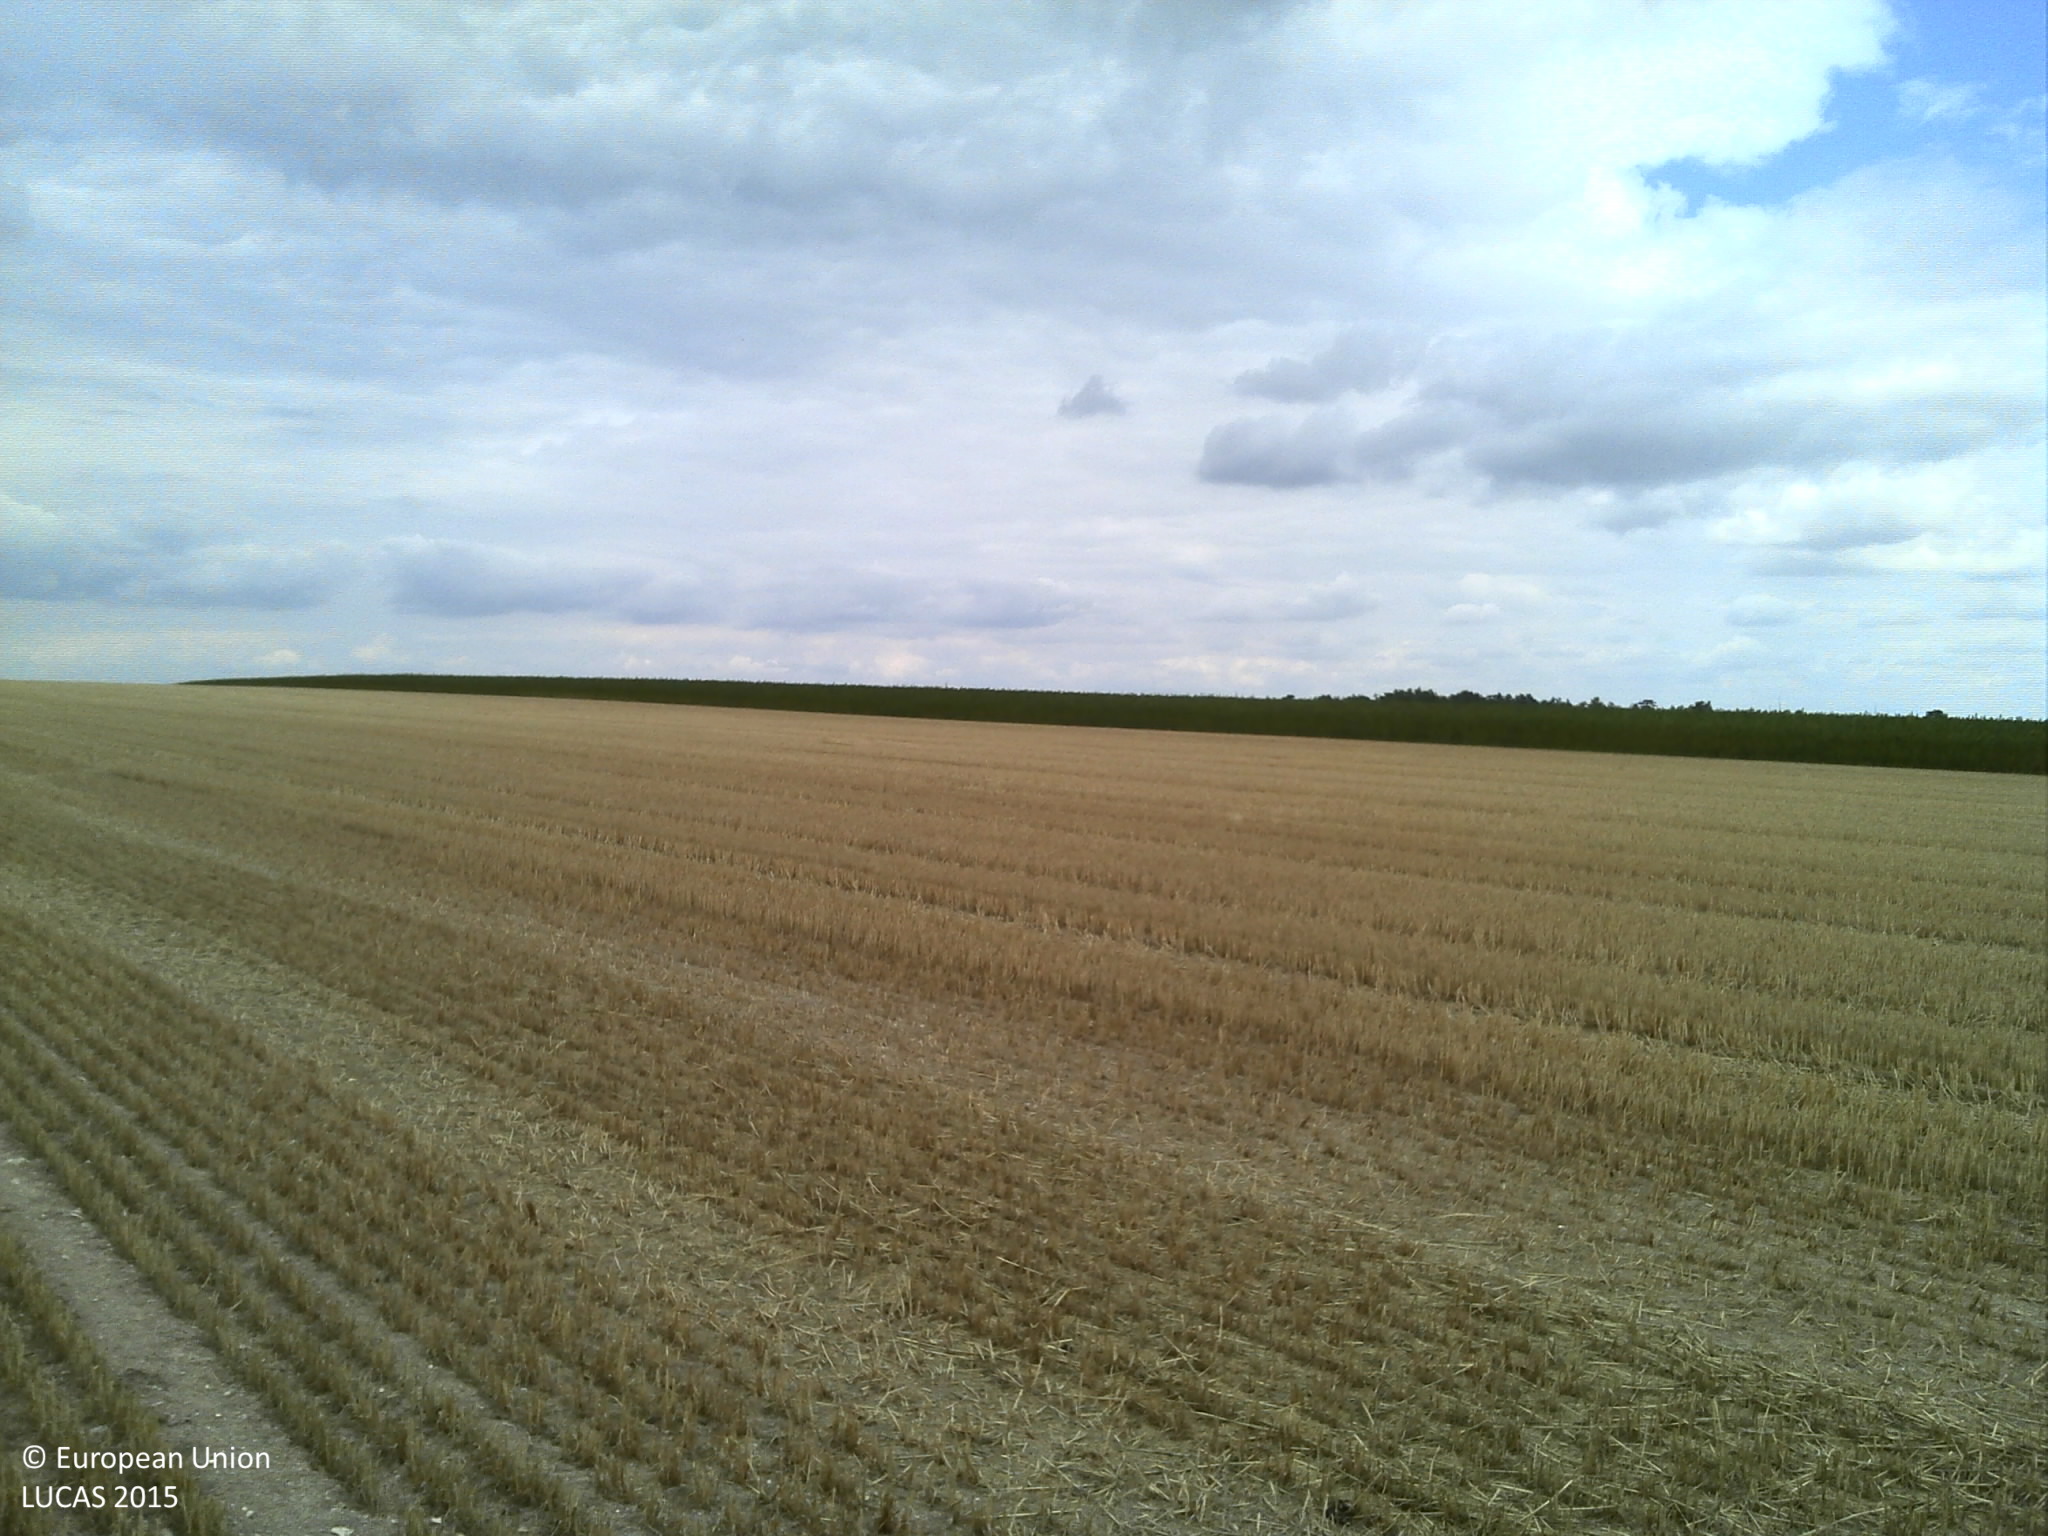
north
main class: Cropland
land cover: Common wheat
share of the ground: > 75 %
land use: Agriculture (excluding fallow land and kitchen gardens)
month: August
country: FR
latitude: 48.4111
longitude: 3.8212
